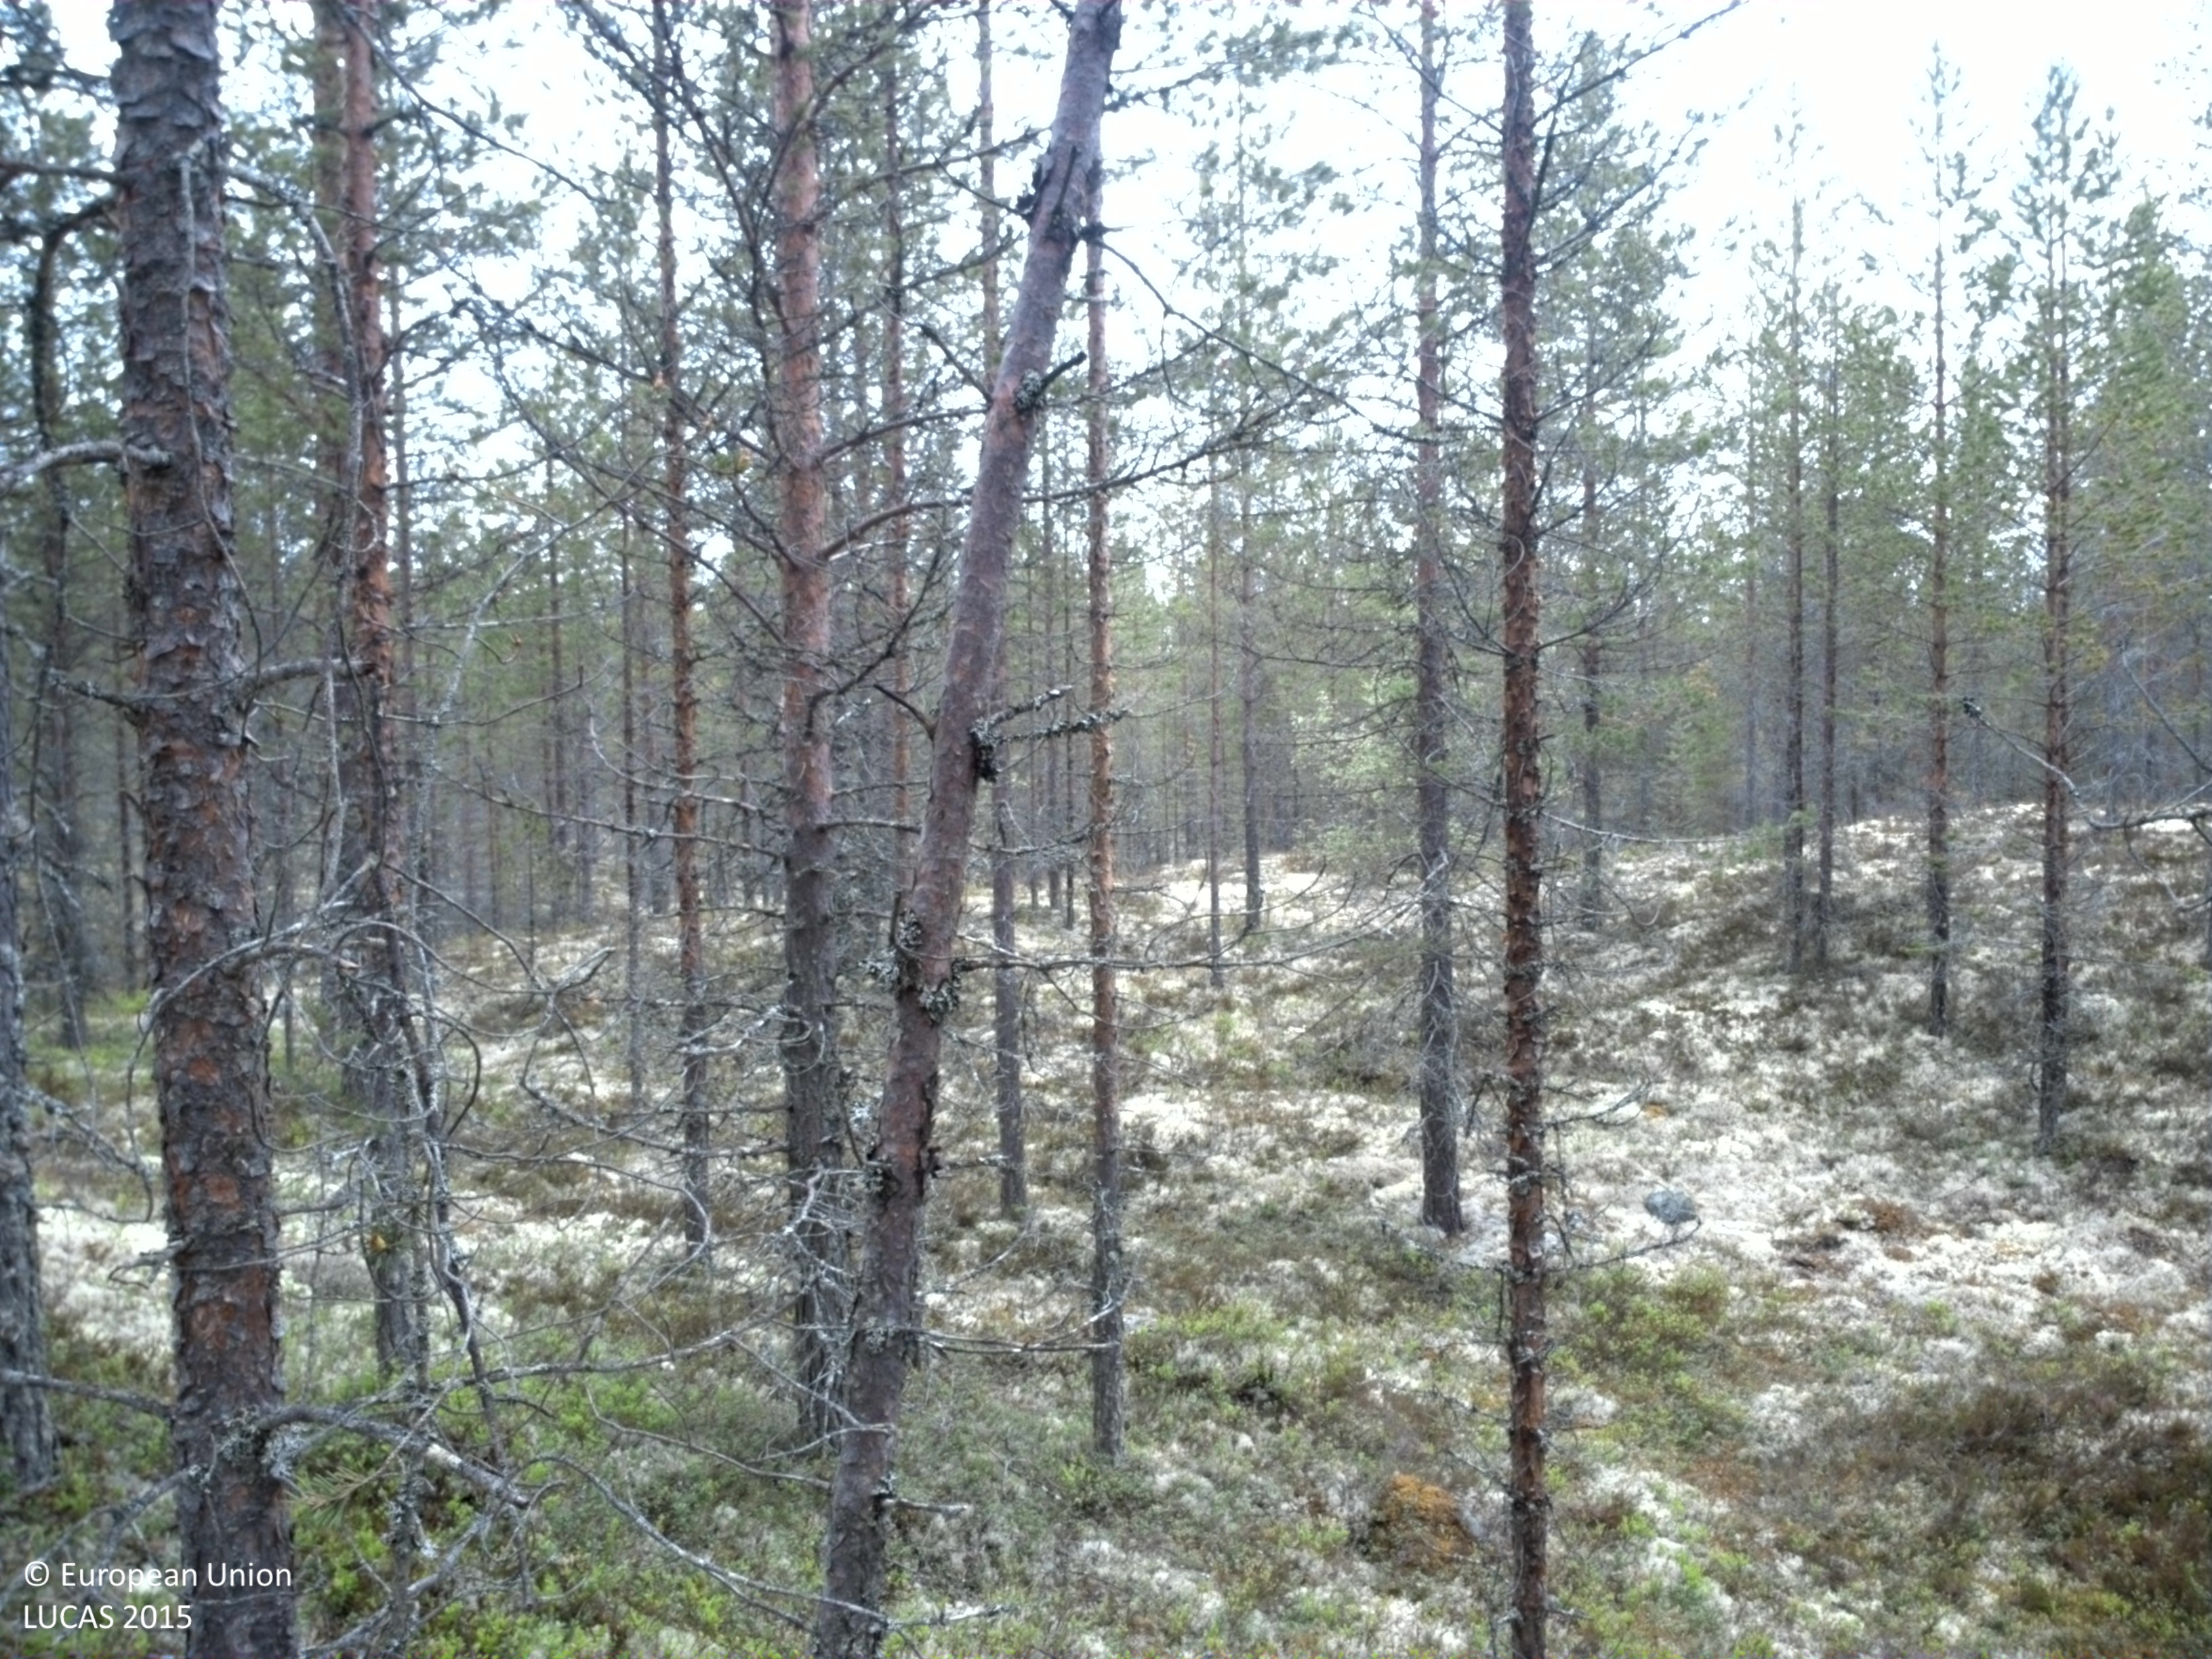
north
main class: Woodland
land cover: Pine dominated coniferous woodland
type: boreal forest
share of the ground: 50 - 75 %
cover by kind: coniferous forest trees 60 %, herbaceous plants 20 %, lichens and mosses 20 %
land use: Forestry
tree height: > 5 m
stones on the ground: 10 - 25 %
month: June
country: SE
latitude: 61.4874
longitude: 13.5739
